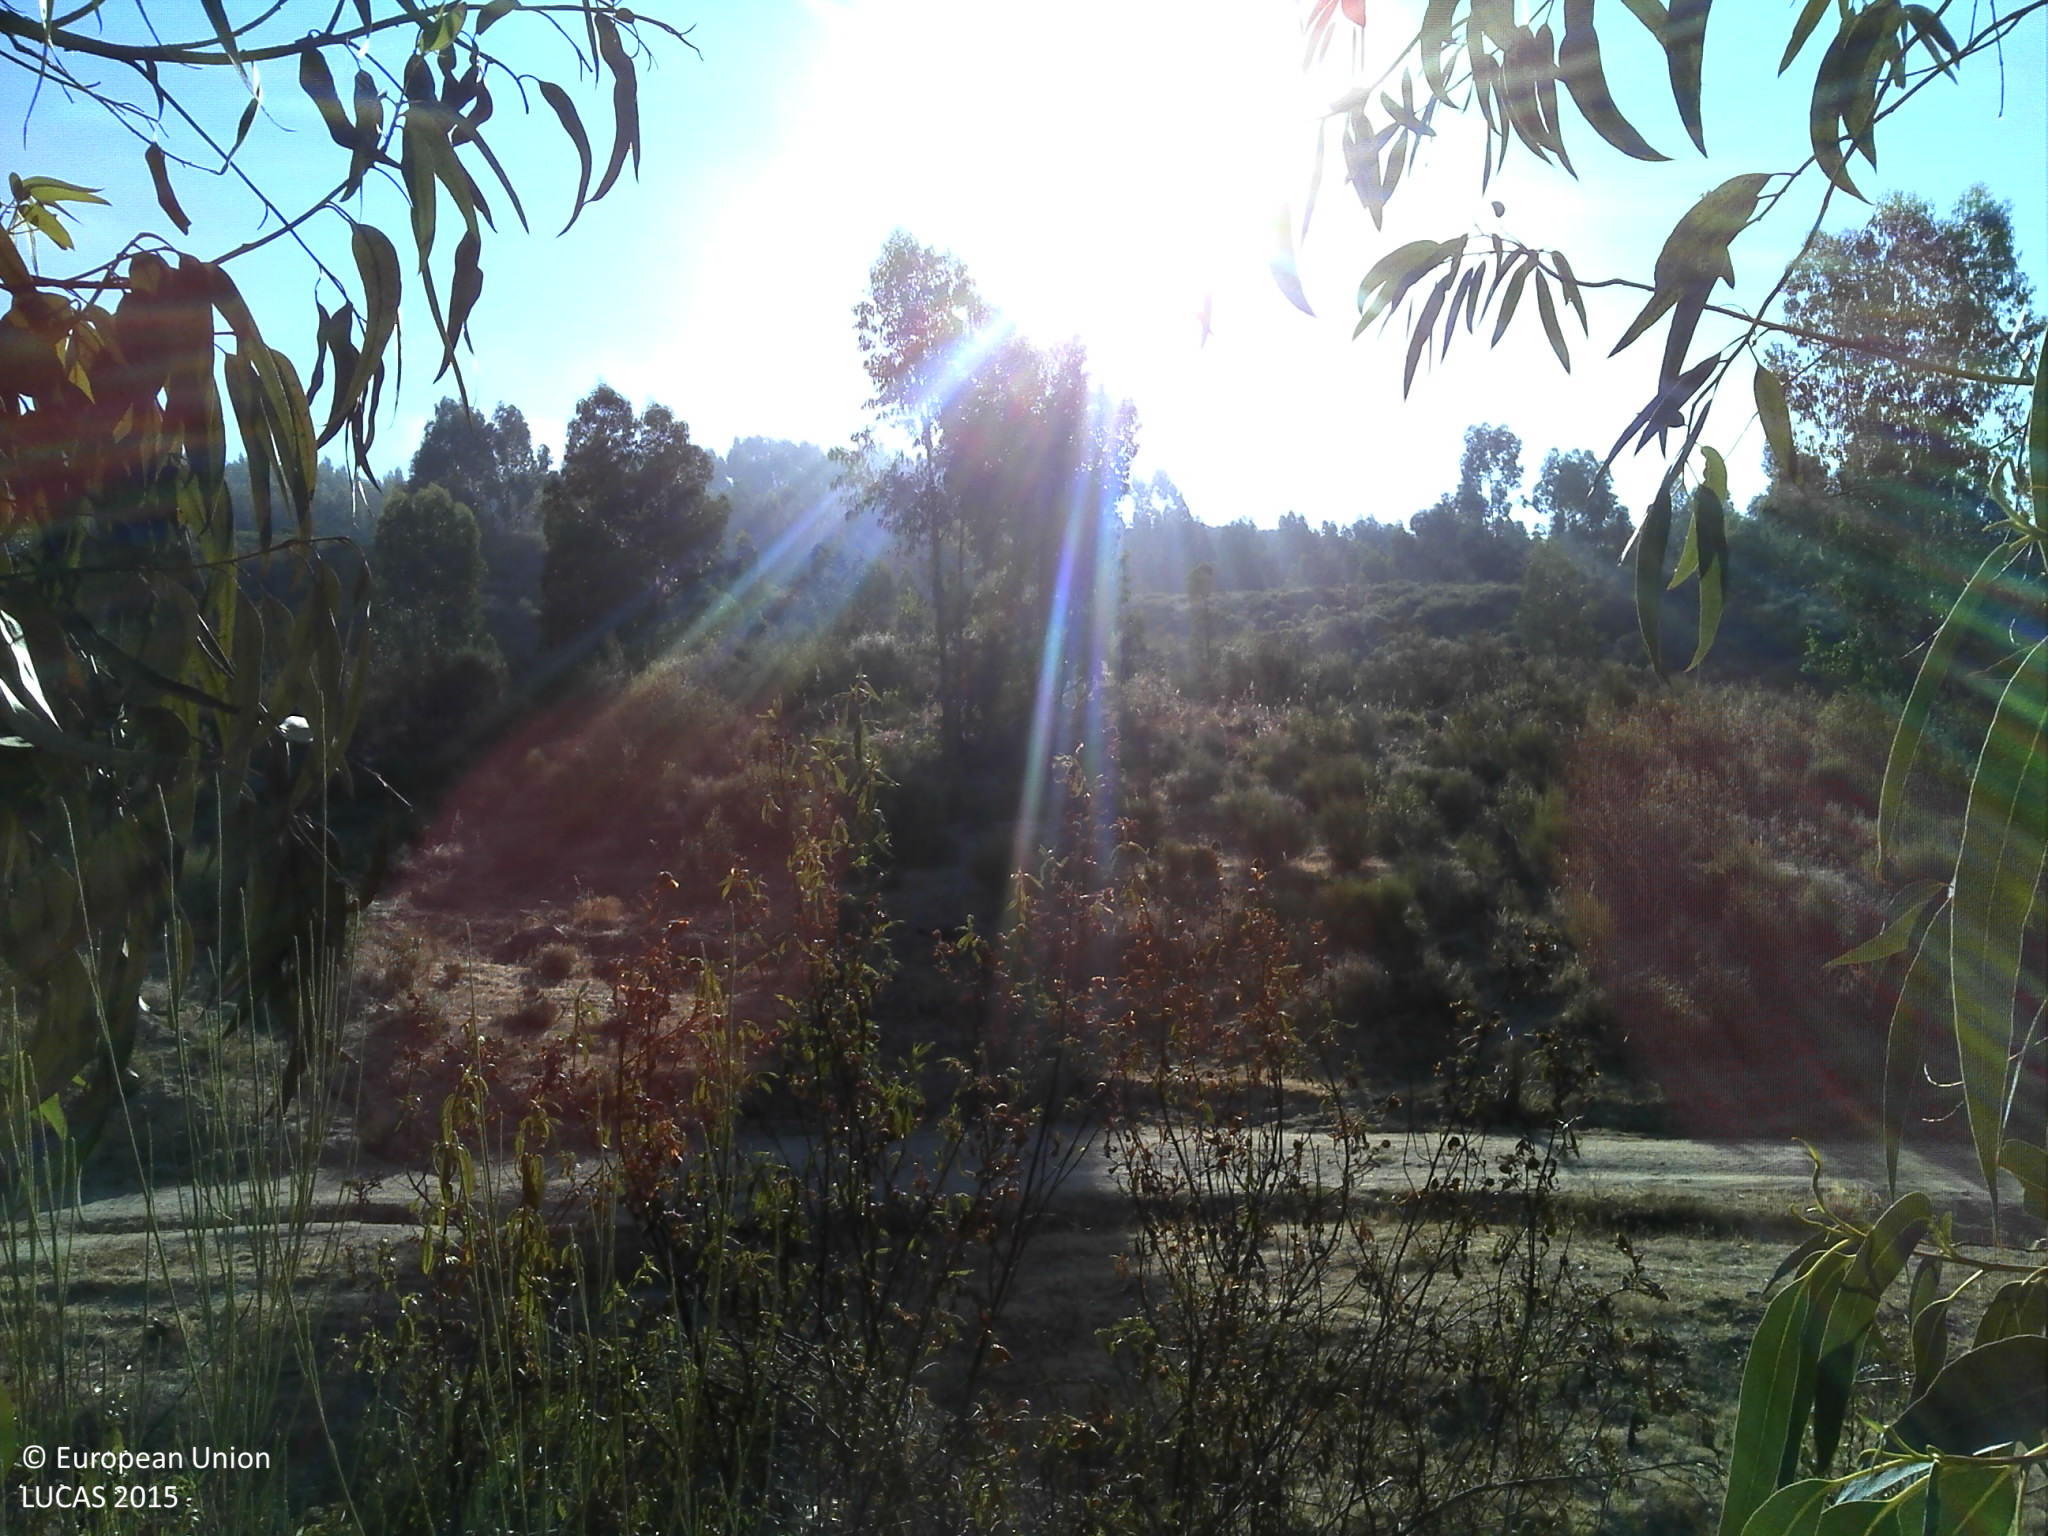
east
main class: Woodland
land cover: Broadleaved woodland
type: broadleaved evergreen forest
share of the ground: 10 - 25 %
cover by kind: unconsolidated bare surface 75 %, broadleaved forest trees 10 %, herbaceous plants 10 %, shrubs 5 %
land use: Forestry
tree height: > 5 m
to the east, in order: Broadleaved woodland; Tracks; Shrubland without tree cover; Rocks and stones; Shrubland without tree cover; Tracks; Broadleaved woodland; Shrubland without tree cover; Tracks; Rocks and stones; Shrubland without tree cover; Tracks; Shrubland without tree cover; Fences; Shrubland with sparse tree cover
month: August
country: PT
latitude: 39.5173
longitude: -7.7690
